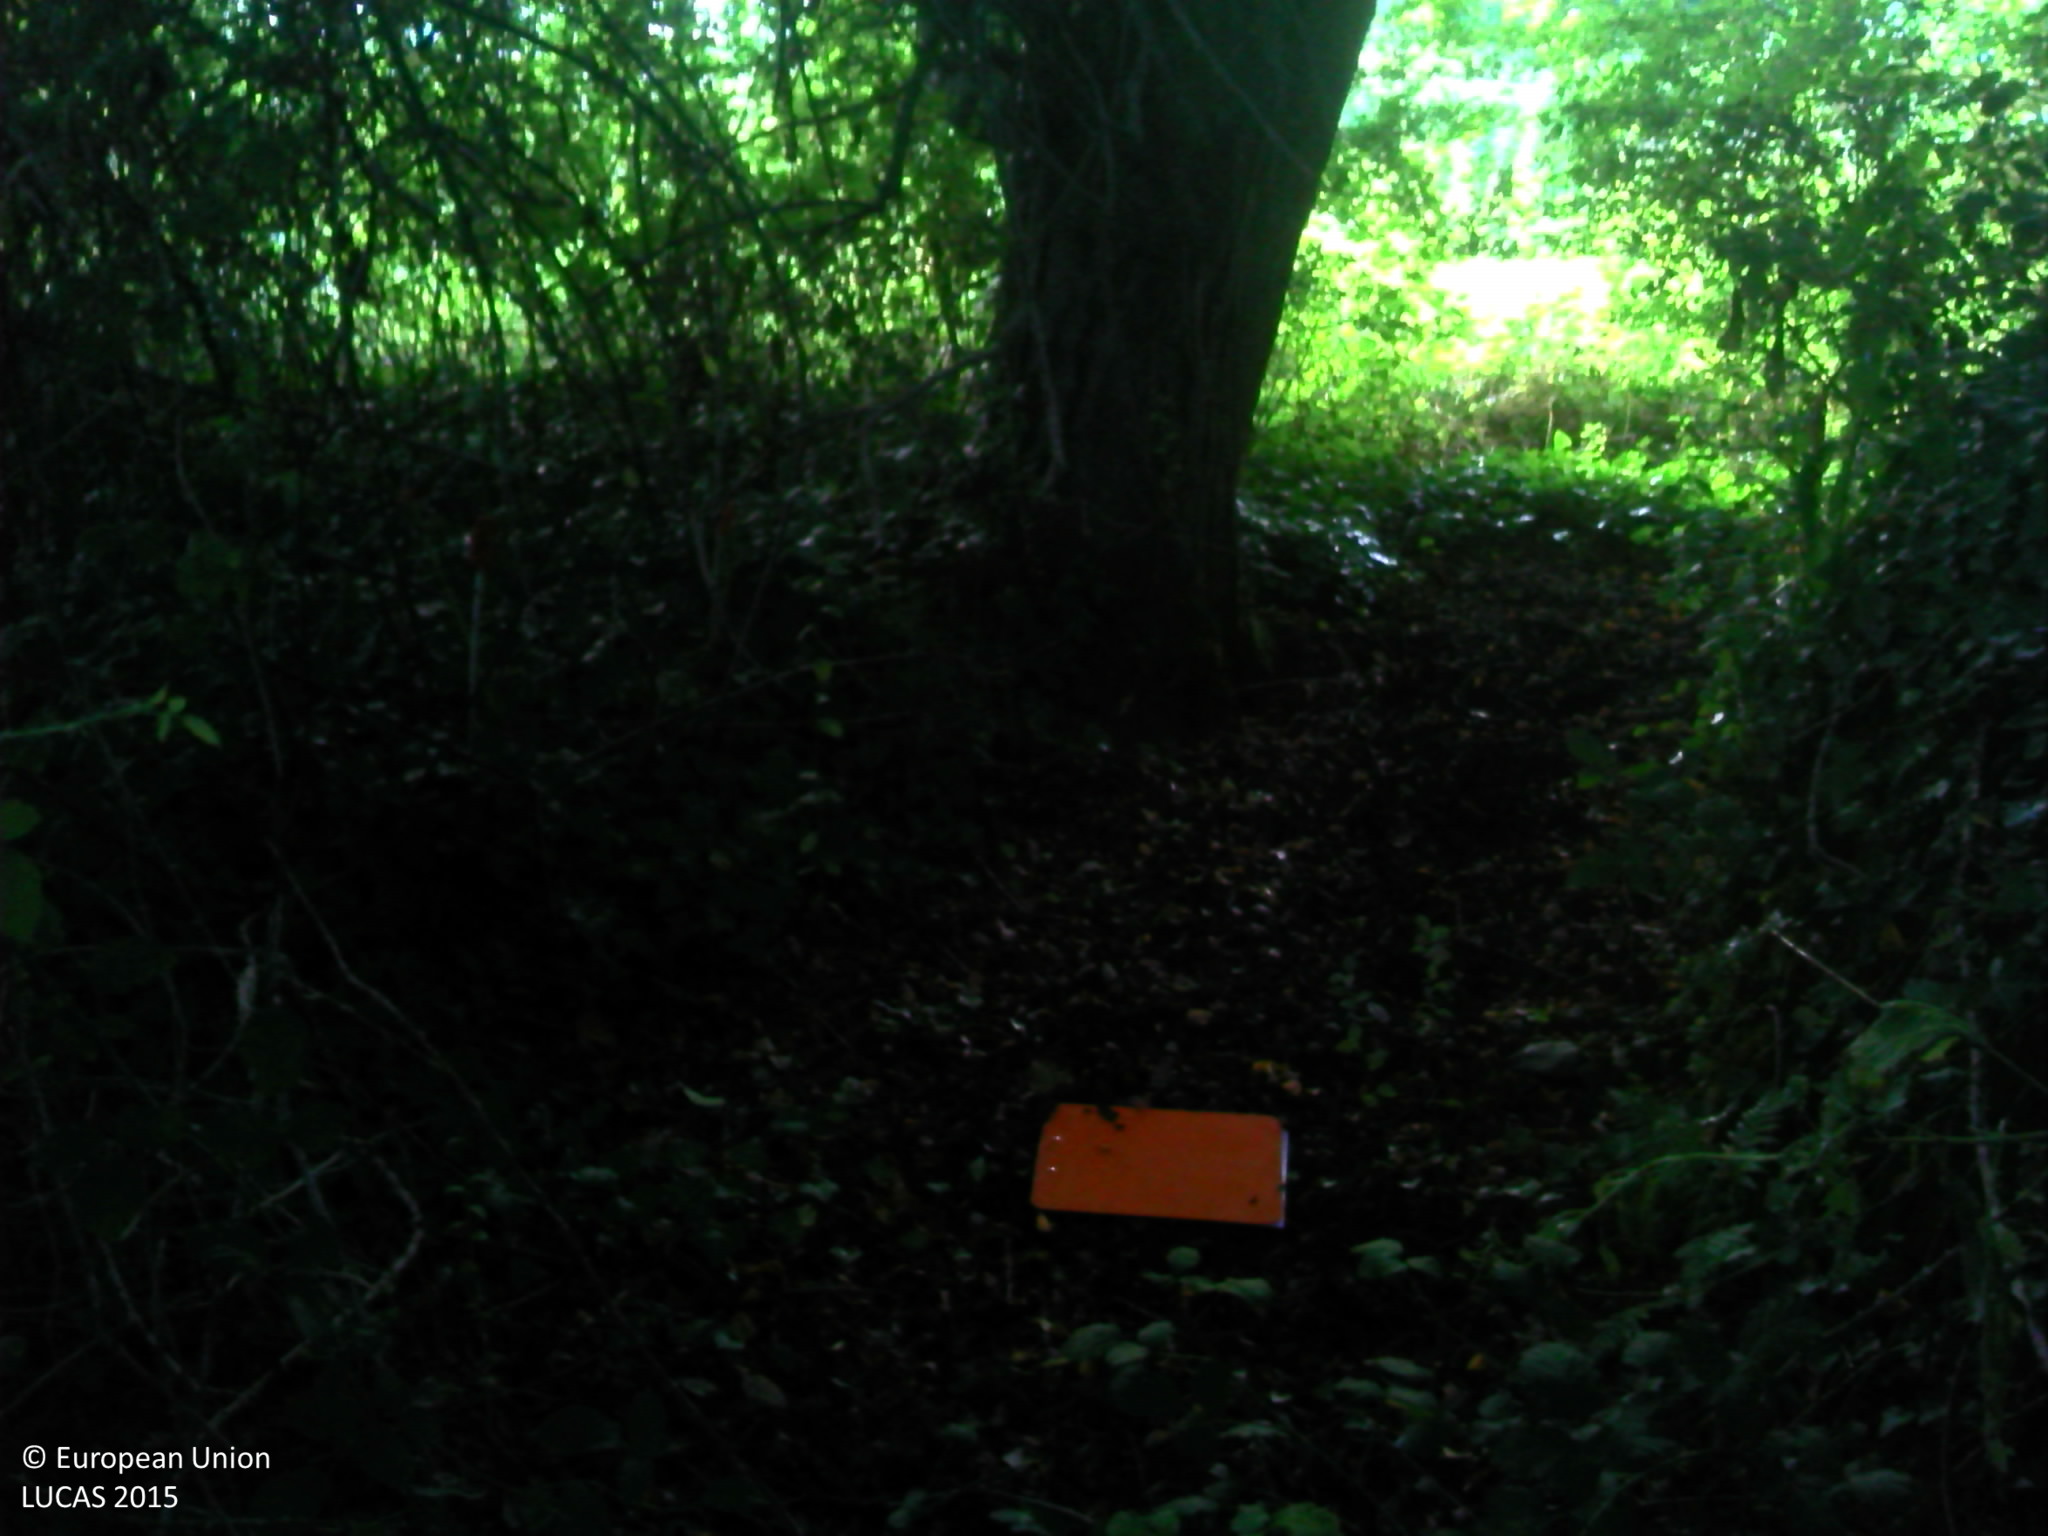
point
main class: Woodland
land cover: Broadleaved woodland
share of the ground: > 75 %
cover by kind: broadleaved forest trees 90 %, shrubs 5 %, herbaceous plants 5 %
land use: Semi-natural and natural areas not in use
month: August
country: FR
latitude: 46.6216
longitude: -1.6501
